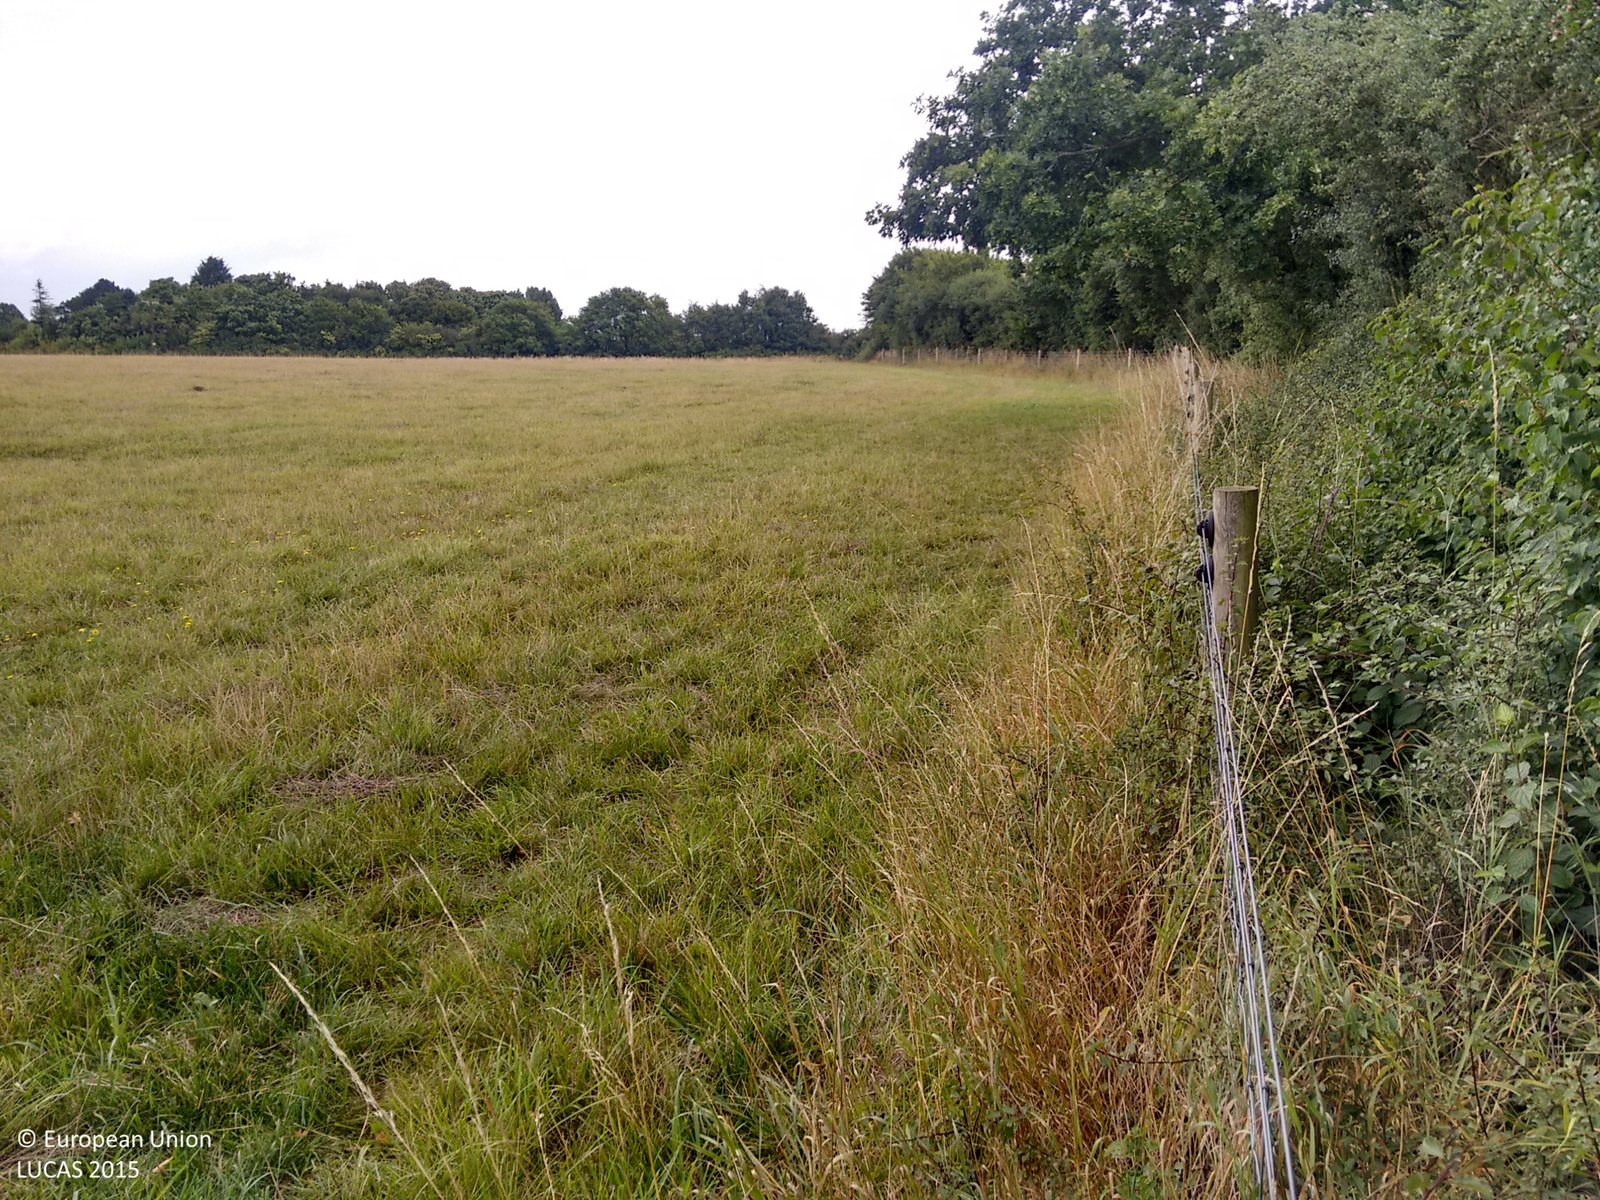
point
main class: Grassland
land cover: Grassland without tree/shrub cover
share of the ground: > 75 %
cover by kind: herbaceous plants 100 %
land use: Agriculture (excluding fallow land and kitchen gardens)
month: August
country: GB
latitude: 52.0850
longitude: 0.9429
